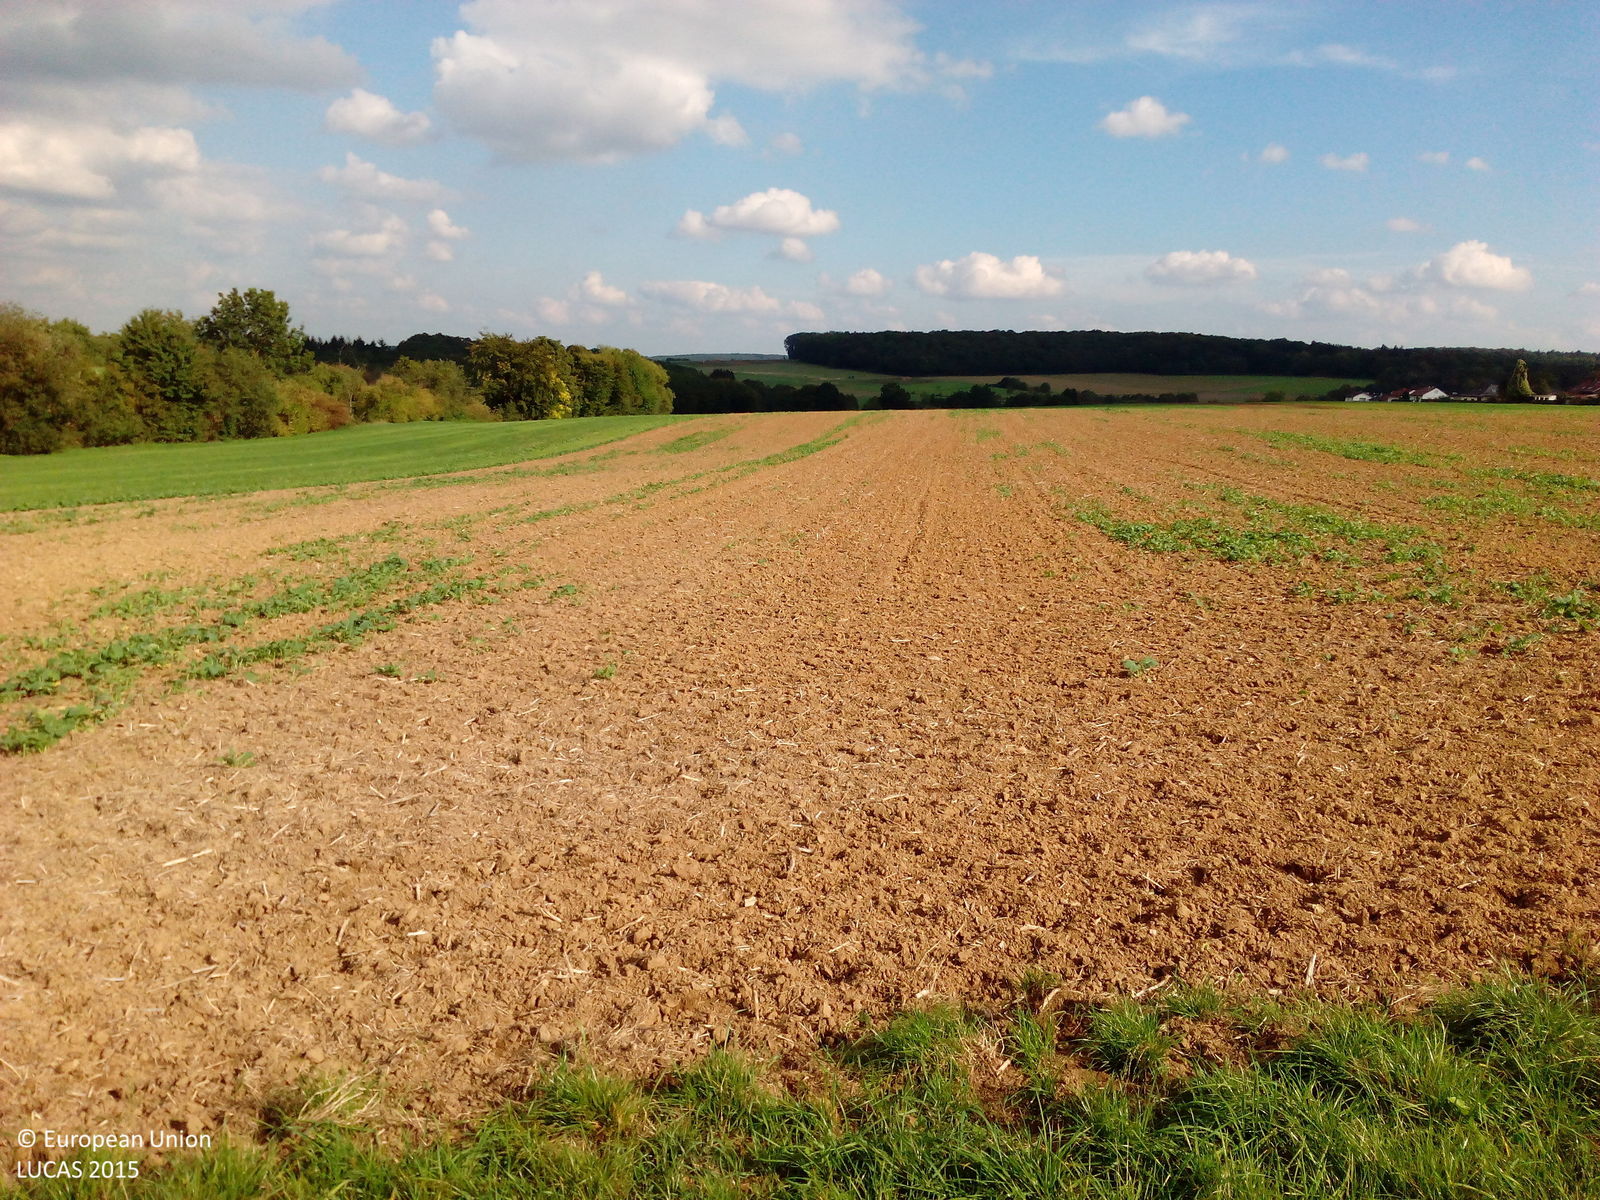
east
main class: Cropland
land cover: Rape and turnip rape
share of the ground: < 10 %
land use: Agriculture (excluding fallow land and kitchen gardens)
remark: Harvested field
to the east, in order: Tracks; Grass margins; Rape and turnip rape; Maize; Broadleaved woodland; Ditches and canals; Grass margins; Paved roads, cycling and walking lanes; Grass margins; Spontaneously vegetated surfaces
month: September
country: DE
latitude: 50.4994
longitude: 8.6046
